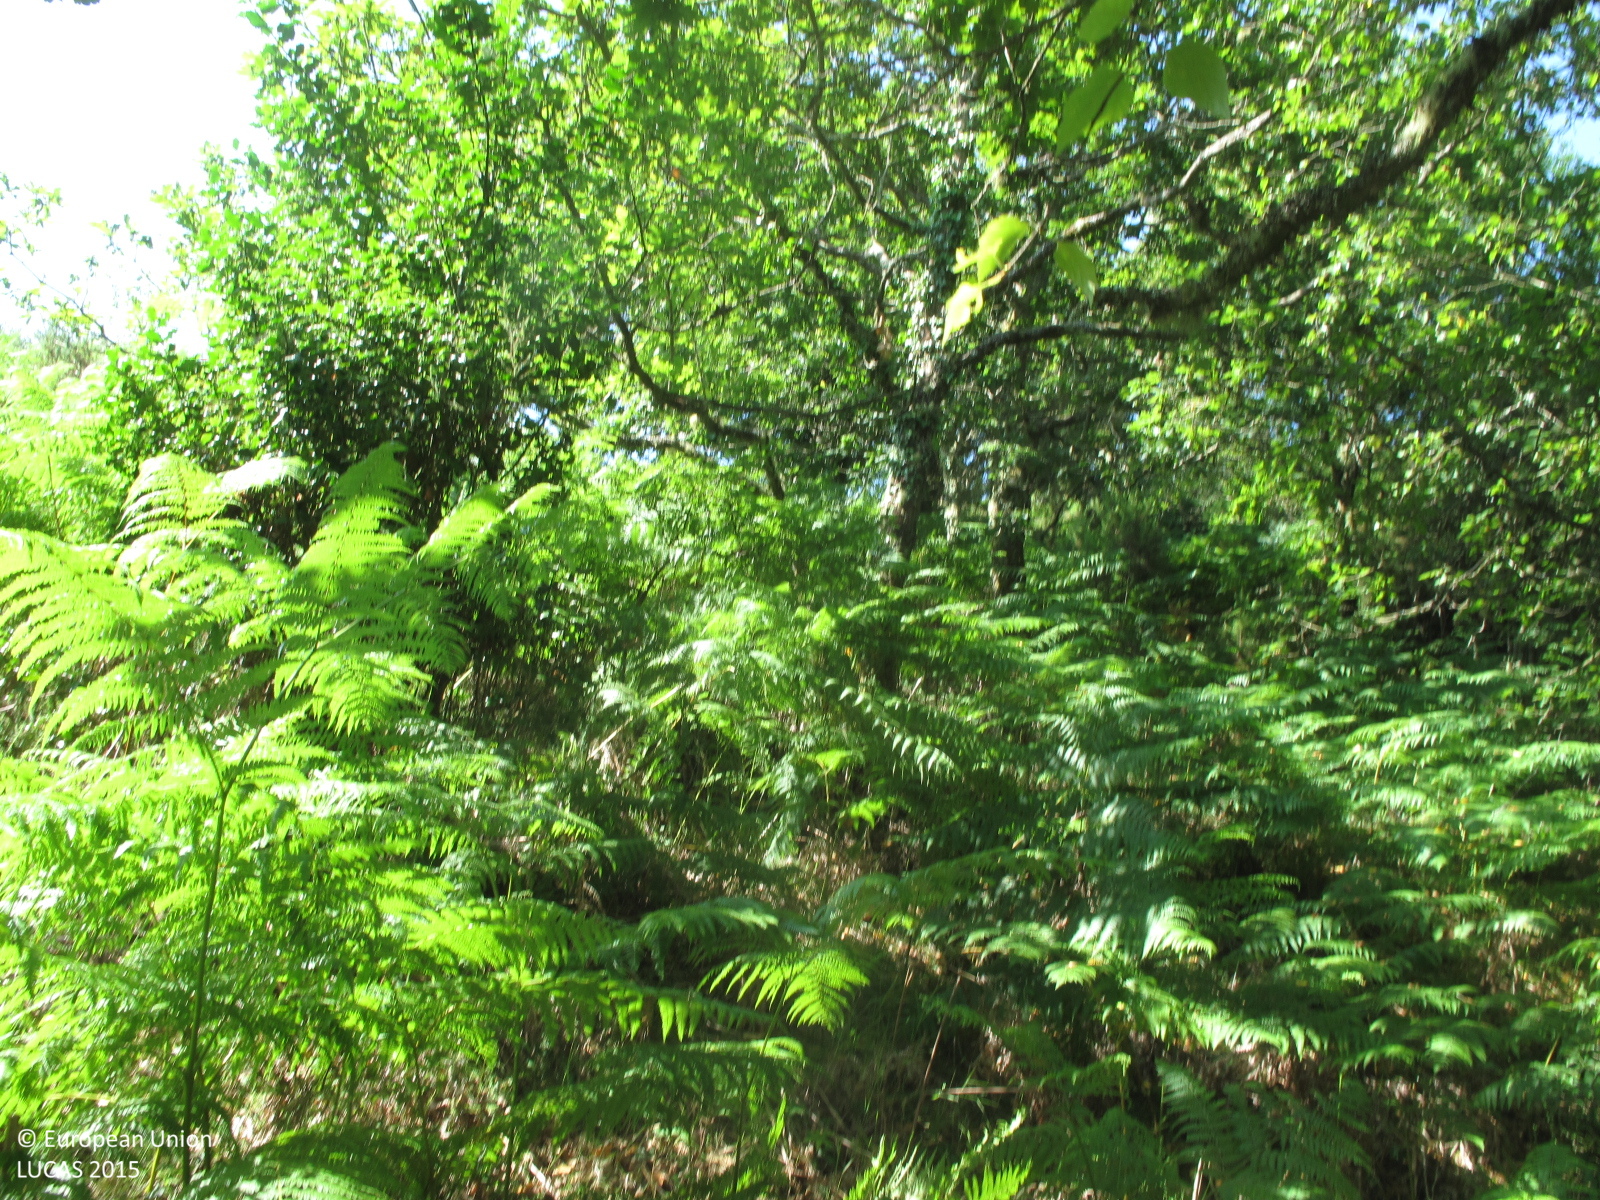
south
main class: Woodland
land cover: Broadleaved woodland
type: acidophilous oak and oak-birch forest
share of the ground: 50 - 75 %
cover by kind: broadleaved forest trees 60 %, shrubs 30 %, herbaceous plants 10 %
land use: Semi-natural and natural areas not in use
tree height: > 5 m
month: July
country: ES
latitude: 43.3341
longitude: -7.9900
